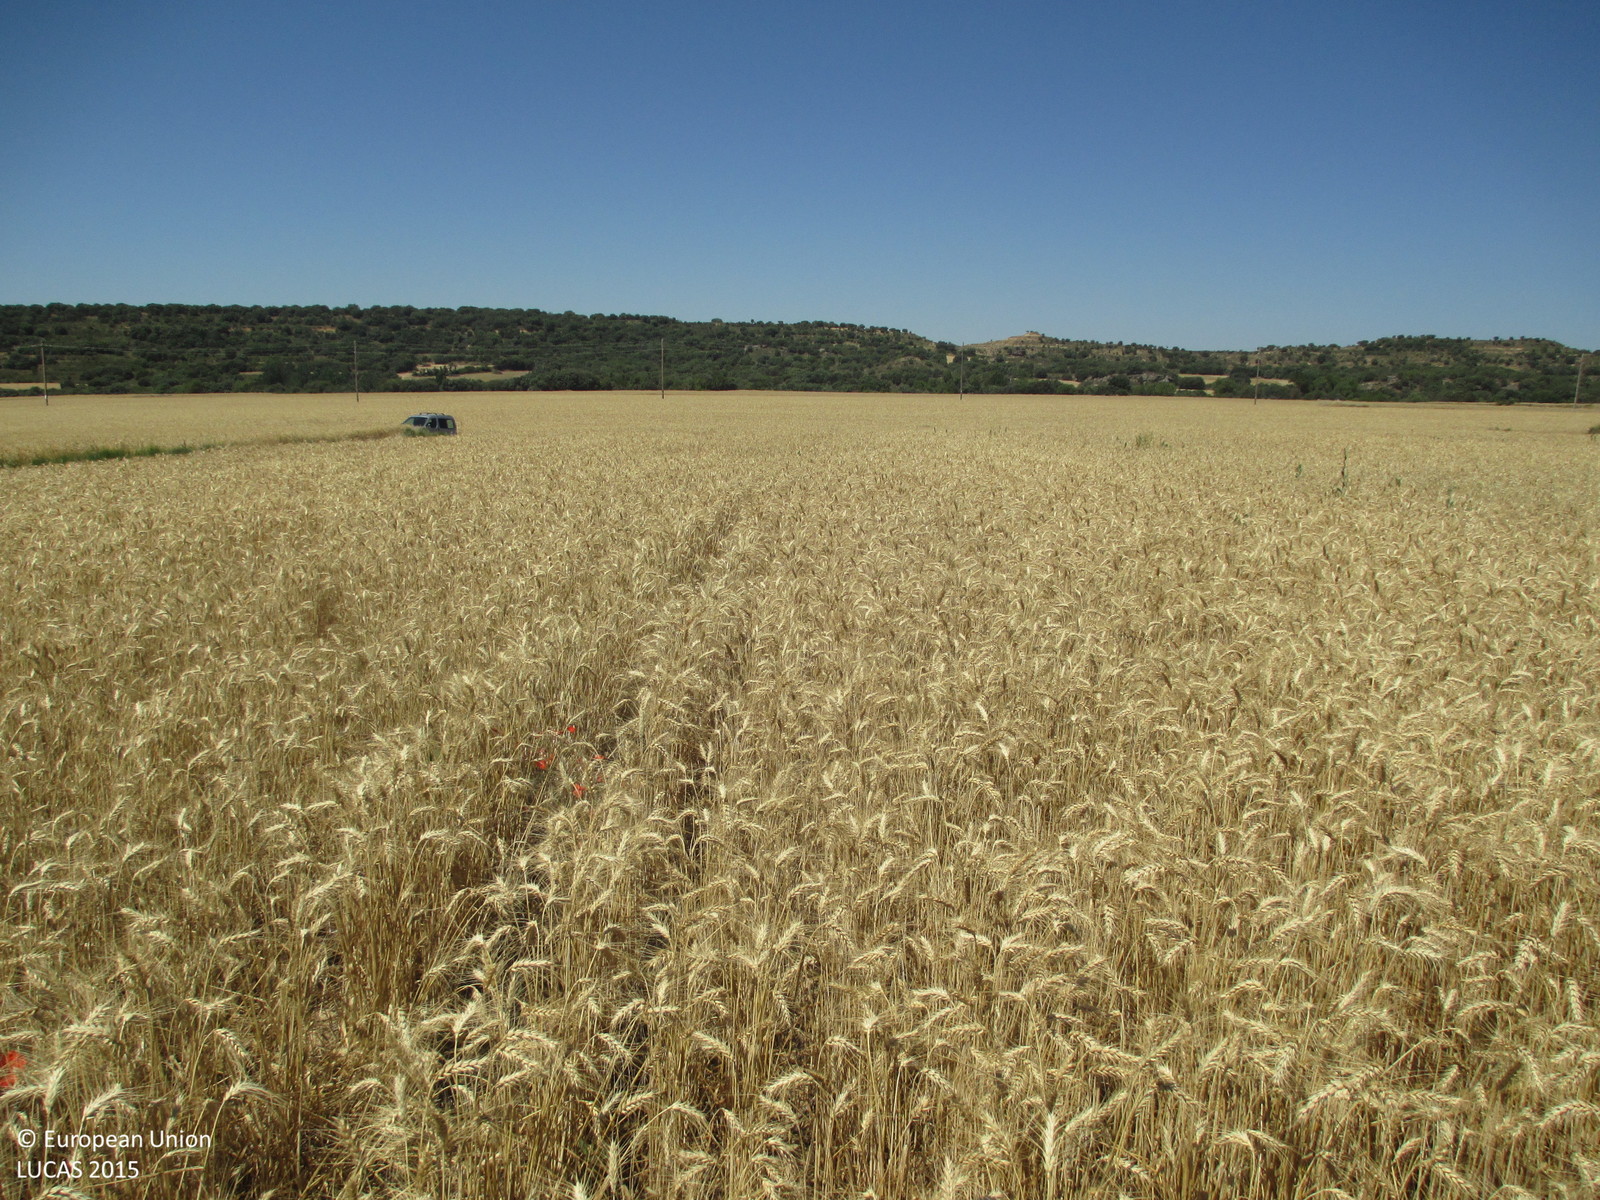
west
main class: Cropland
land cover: Durum wheat
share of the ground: > 75 %
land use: Agriculture (excluding fallow land and kitchen gardens)
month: June
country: ES
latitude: 42.1795
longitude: -0.3253
